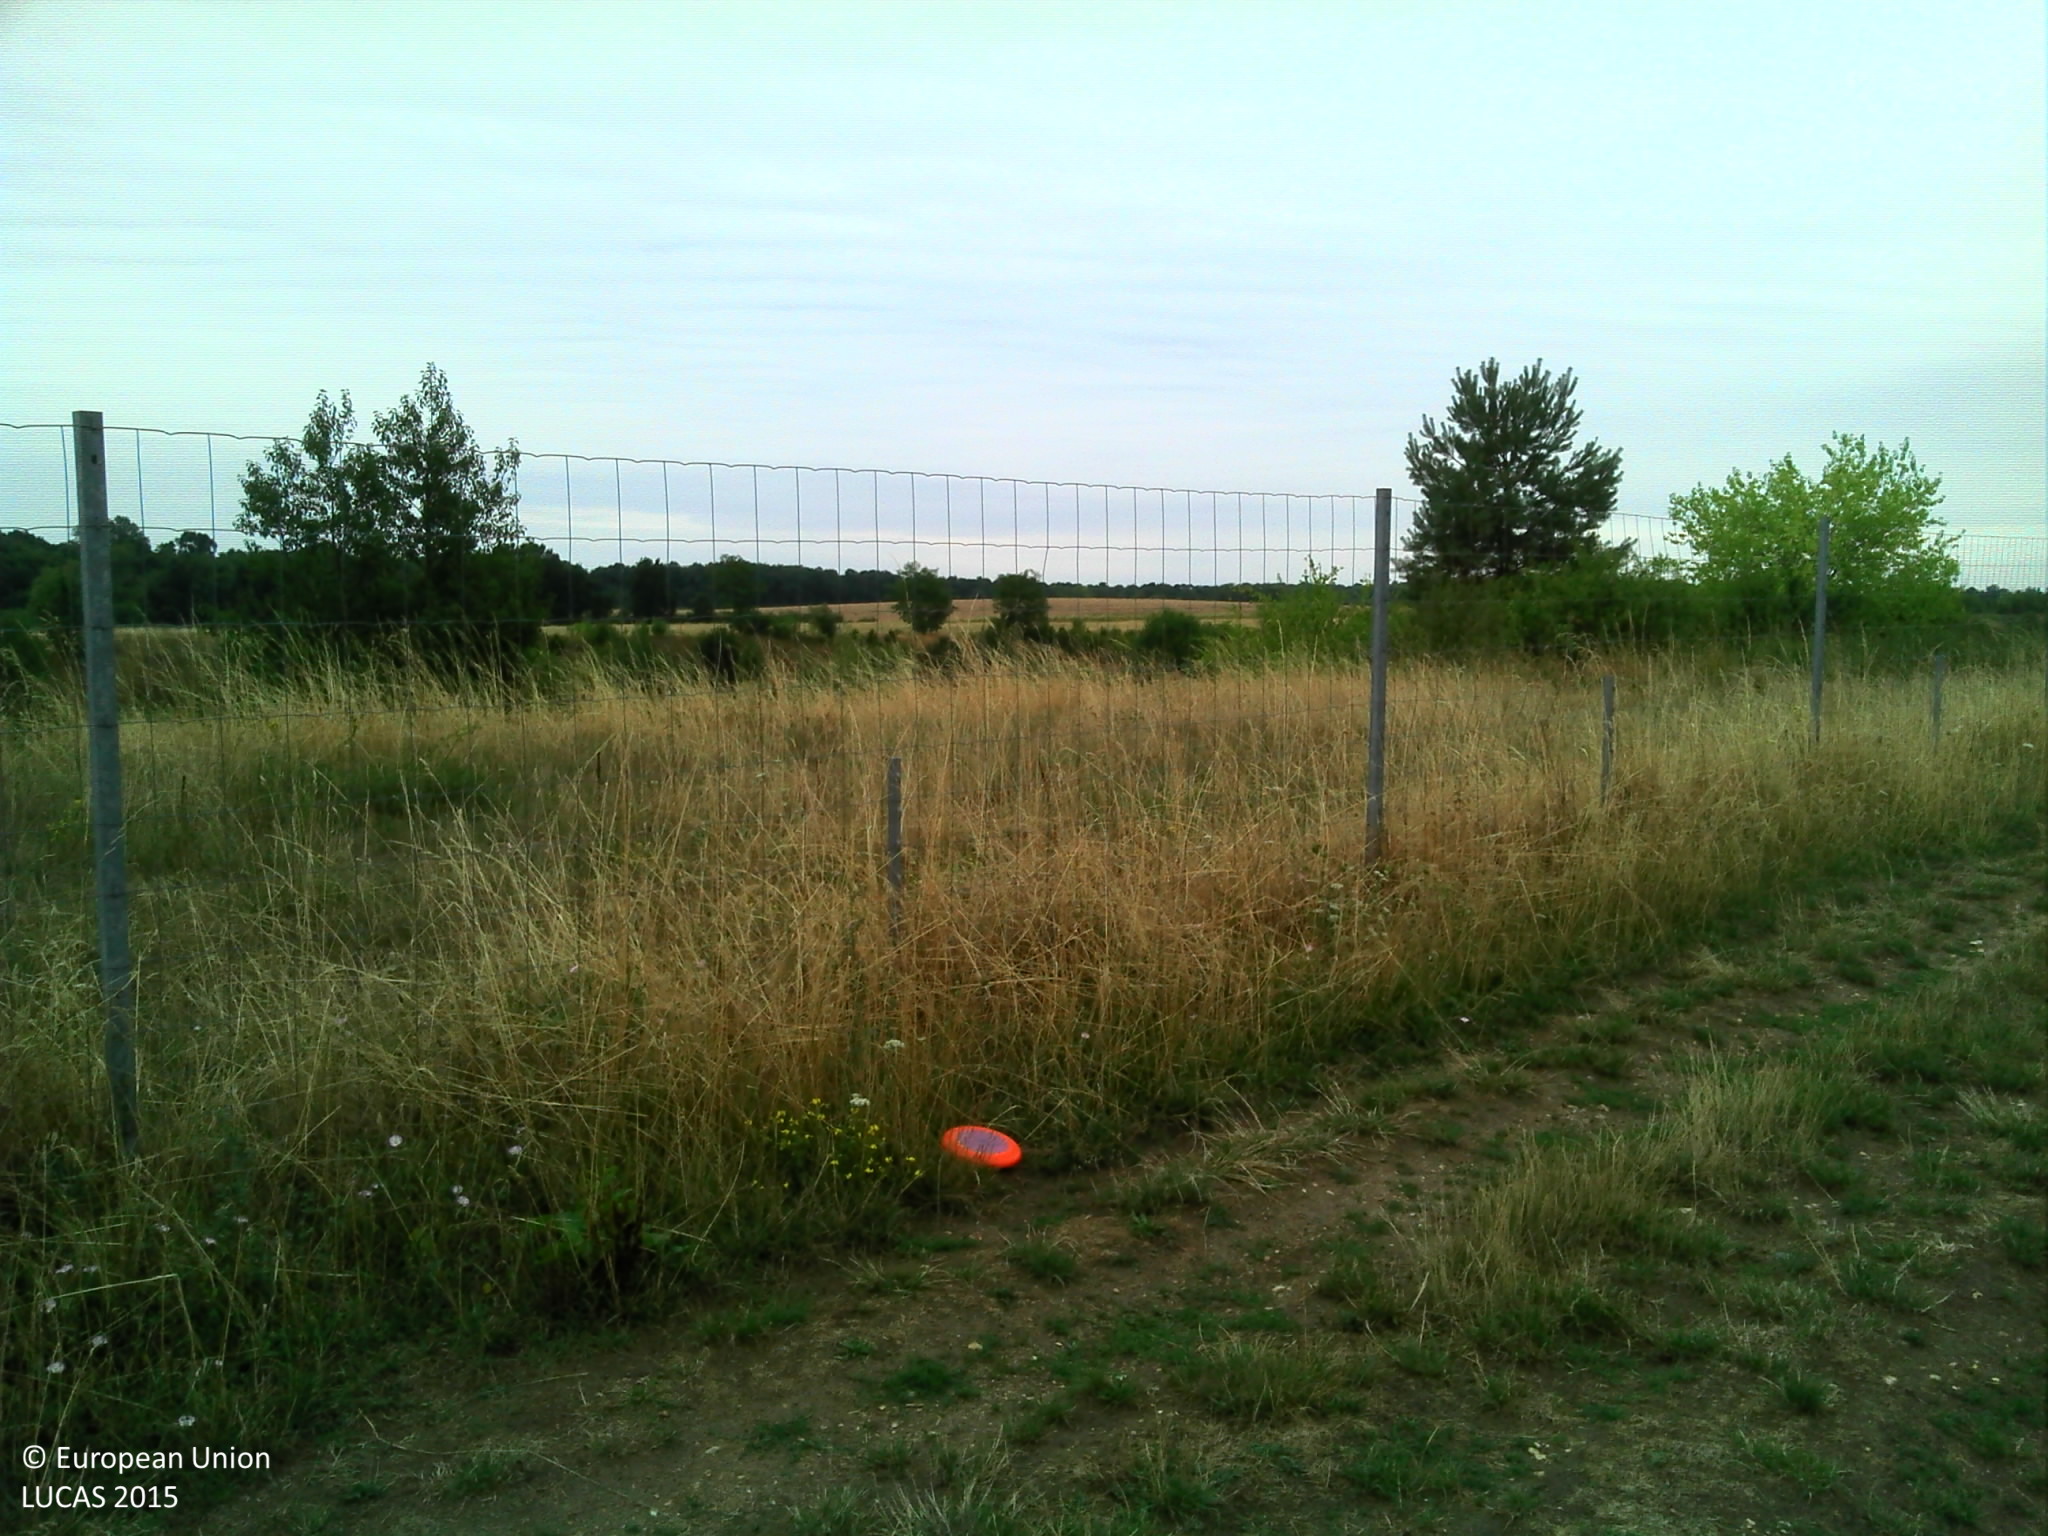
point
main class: Grassland
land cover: Grassland with sparse tree/shrub cover
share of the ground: > 75 %
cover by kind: herbaceous plants 95 %, broadleaved forest trees 5 %
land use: Semi-natural and natural areas not in use
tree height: < 5 m
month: August
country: FR
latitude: 48.1471
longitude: 2.7468
